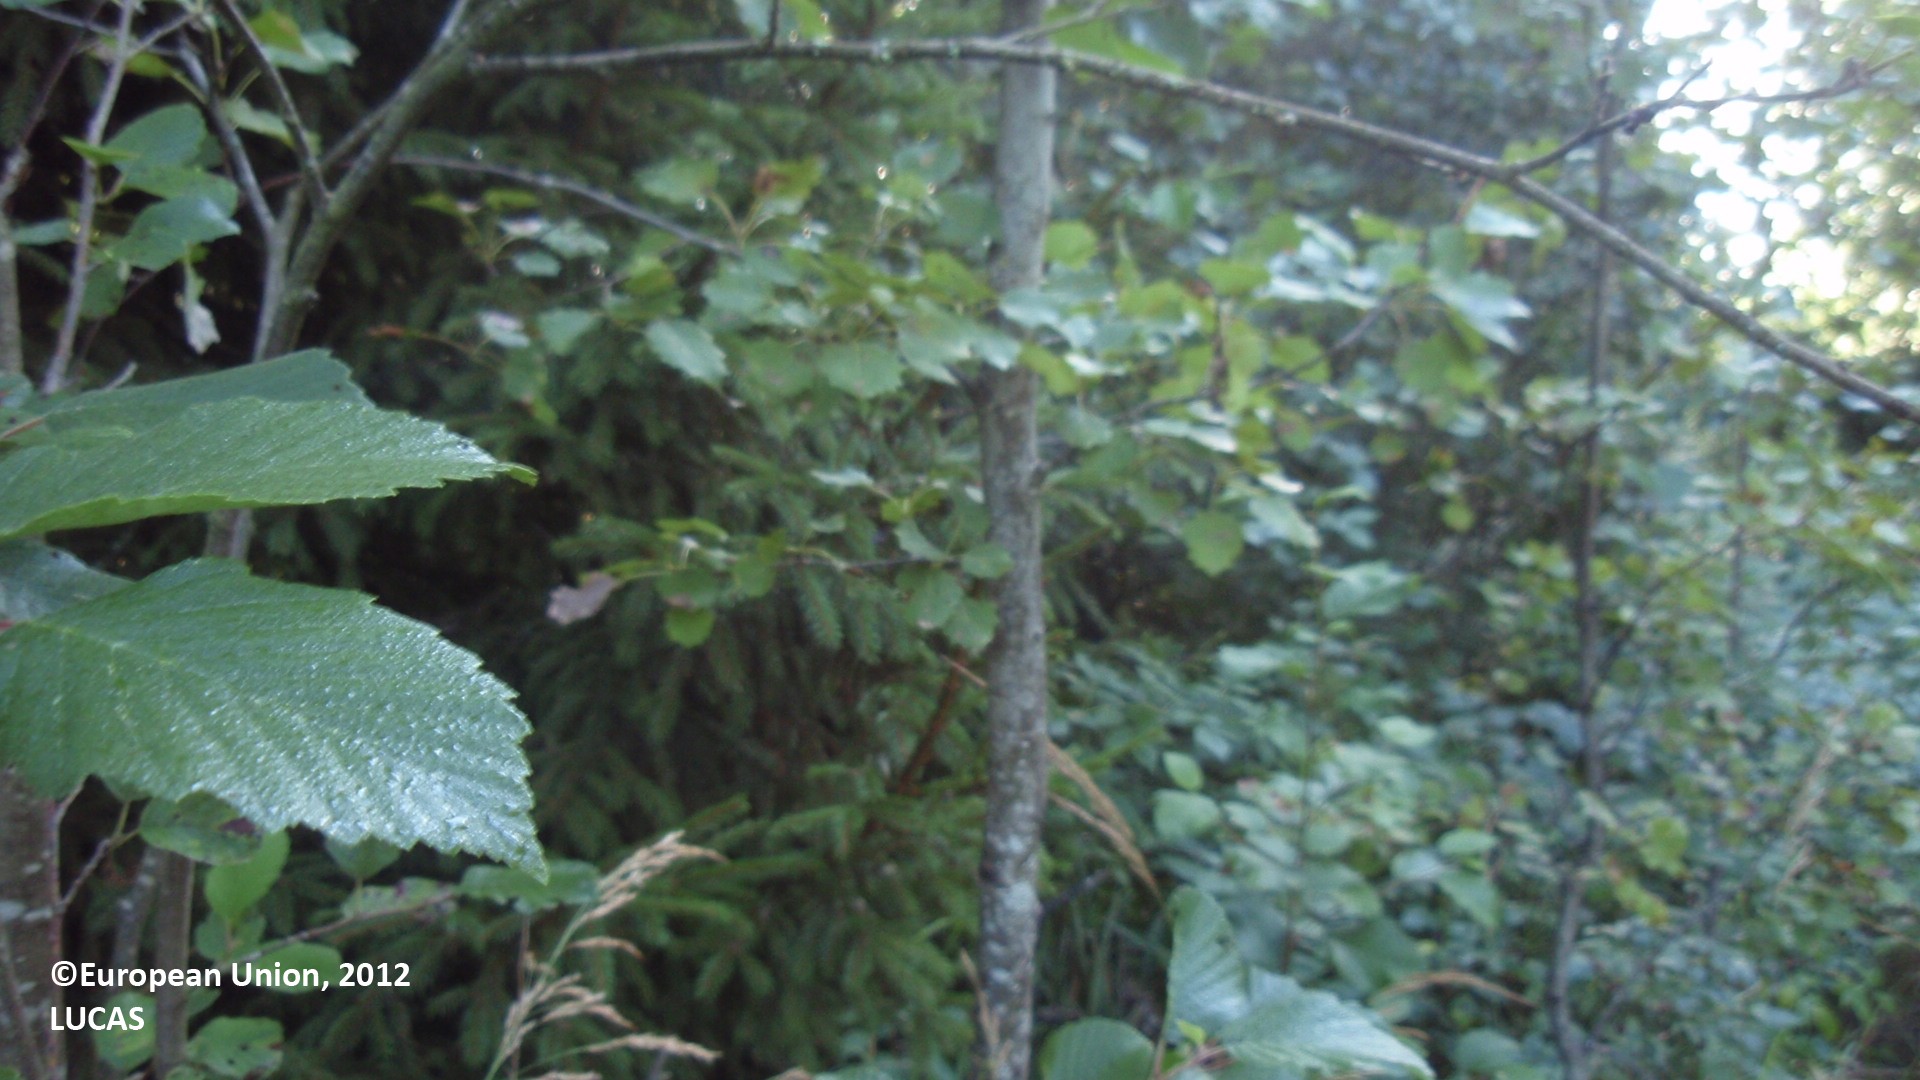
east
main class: Woodland
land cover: Broadleaved woodland
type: boreal forest
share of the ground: 50 - 75 %
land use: Forestry
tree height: > 5 m
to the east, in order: Broadleaved woodland; Ditches and canals; Broadleaved woodland; Temporary grasslands; Ditches and canals; Oats; Ditches and canals; Grassland without tree/shrub cover
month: August
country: FI
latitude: 60.6205
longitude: 27.2636
